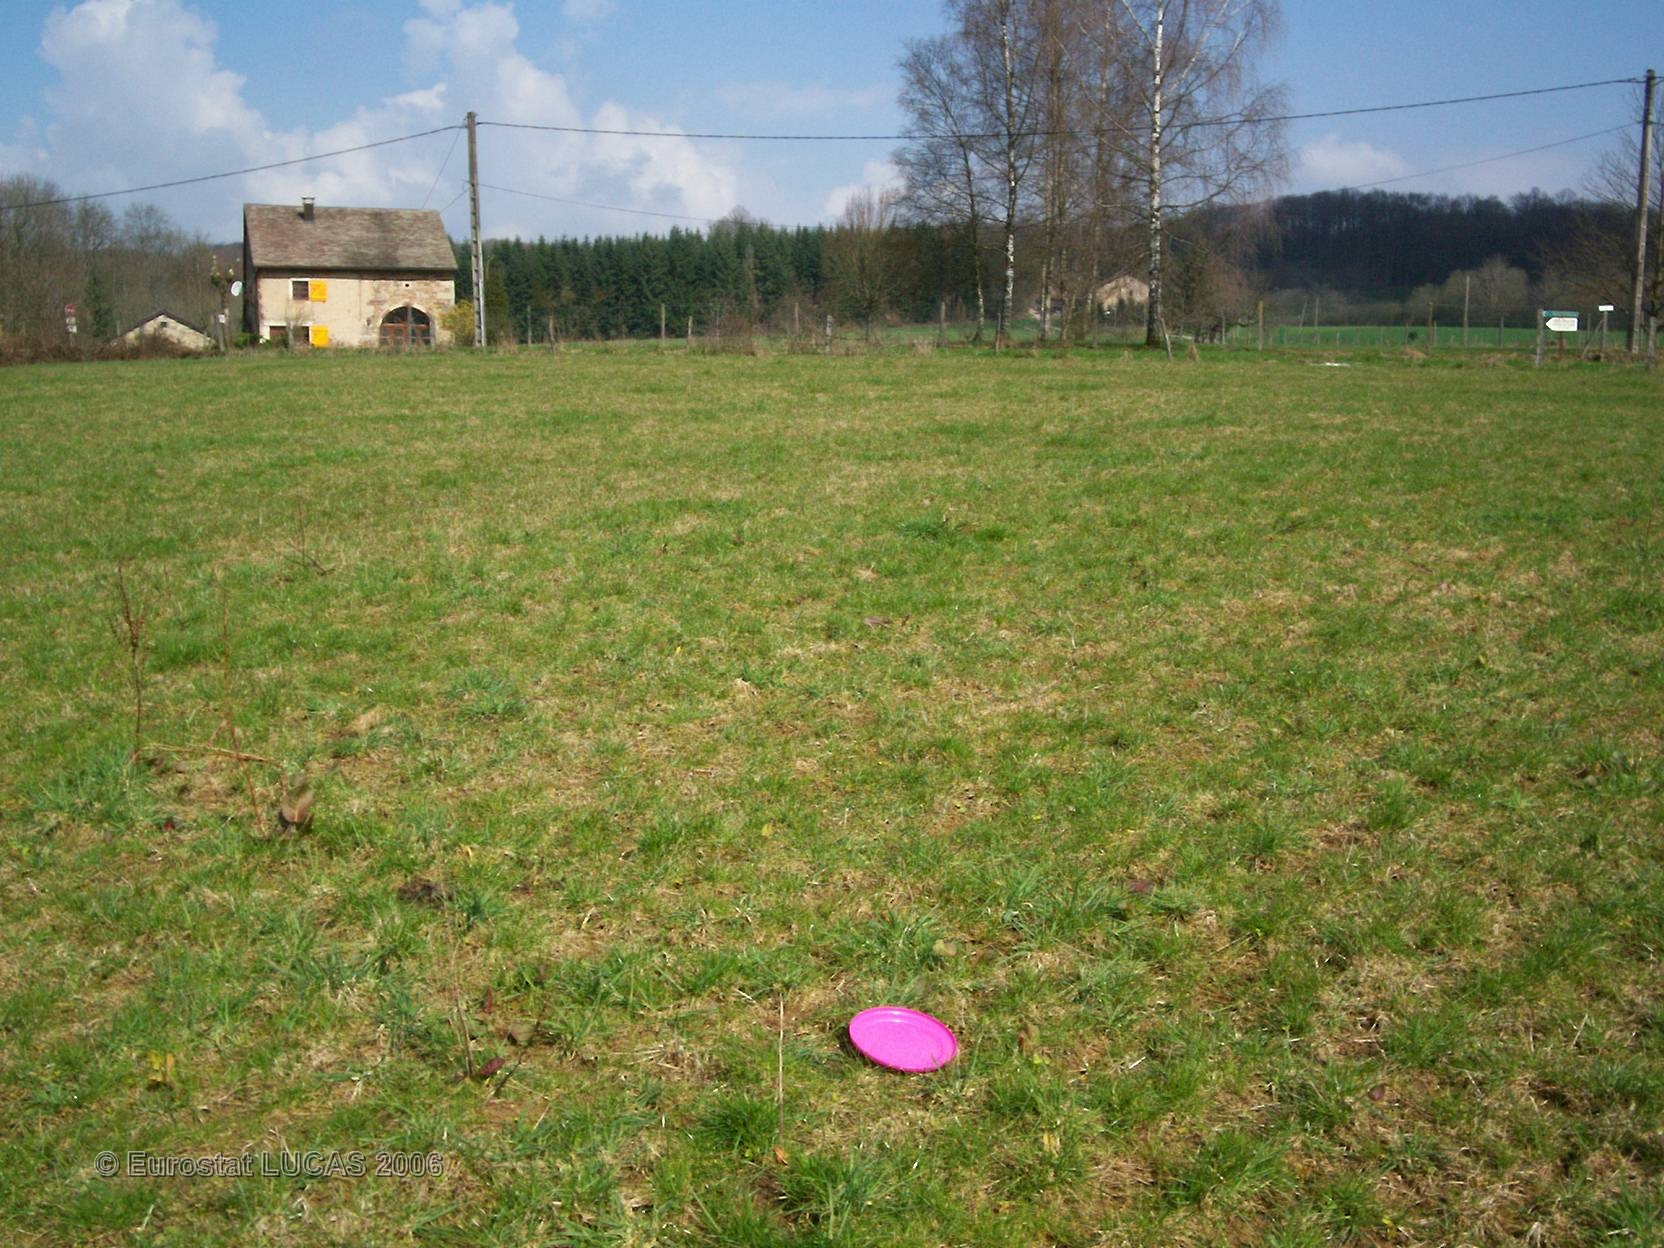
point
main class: Grassland
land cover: Grassland without tree/shrub cover
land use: Agriculture (excluding fallow land and kitchen gardens)
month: April
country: FR
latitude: 47.9262
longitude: 6.2669
